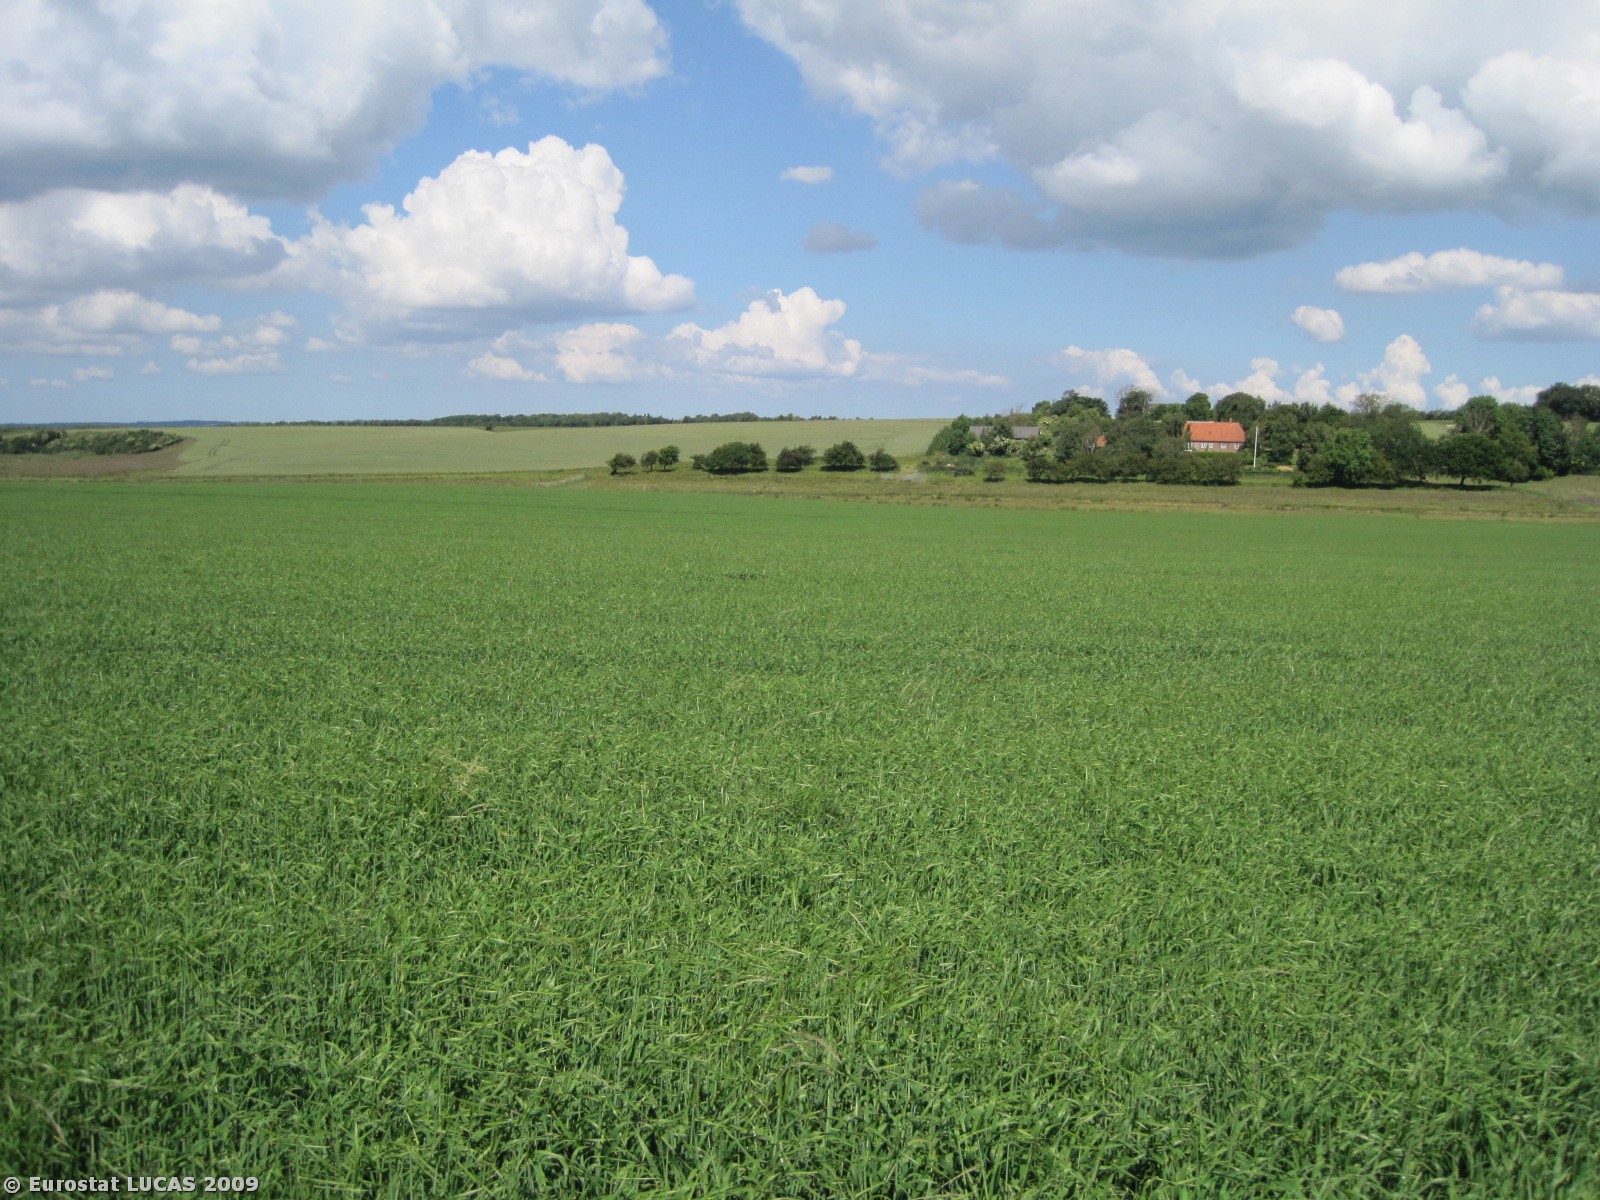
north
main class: Cropland
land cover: Barley
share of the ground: > 75 %
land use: Agriculture (excluding fallow land and kitchen gardens)
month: June
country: DK
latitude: 56.6682
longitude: 8.8756
